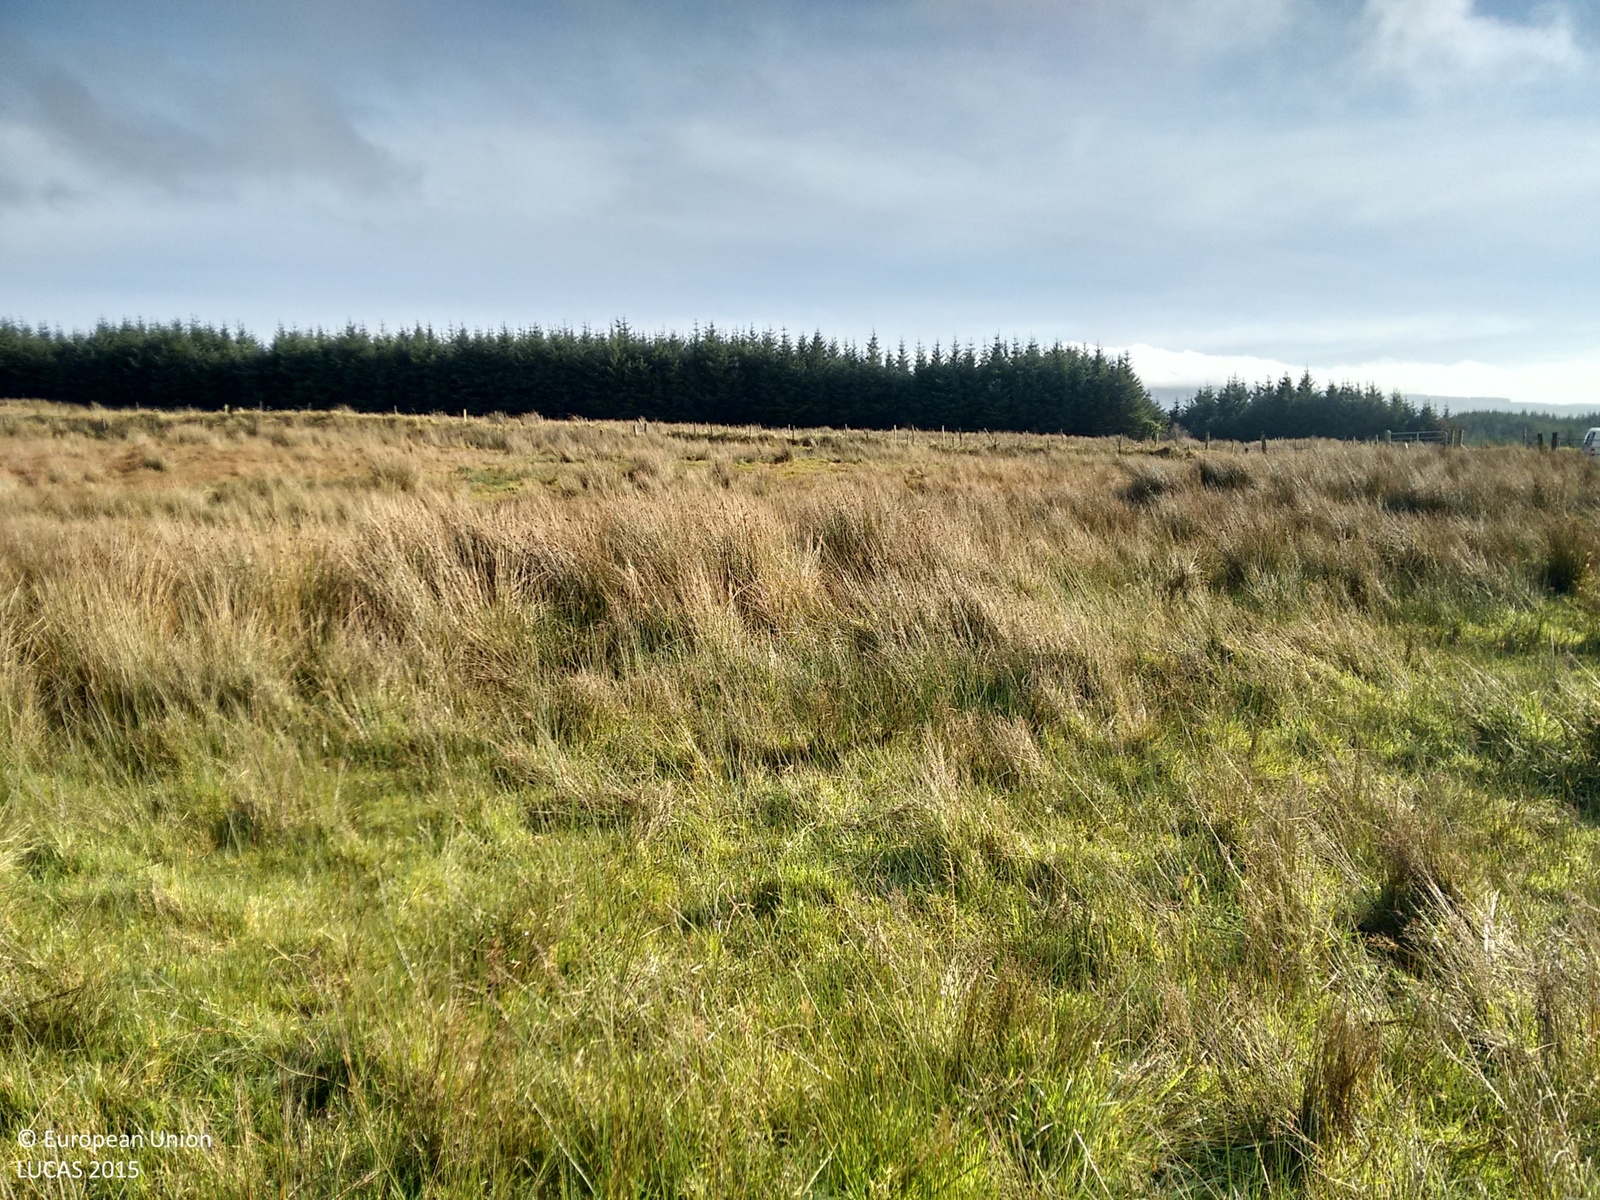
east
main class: Grassland
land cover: Grassland without tree/shrub cover
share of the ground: > 75 %
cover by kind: herbaceous plants 100 %
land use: Agriculture (excluding fallow land and kitchen gardens)
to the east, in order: Grassland without tree/shrub cover; Ponds and wetlands; Ditches and canals; Grassland without tree/shrub cover; Fences; Shruby margins; Ditches and canals; Paved roads, cycling and walking lanes; Ditches and canals; Fences; Grassland without tree/shrub cover; Ditches and canals; Grassland without tree/shrub cover; Ditches and canals; Fences; Spruce dominated coniferous woodland; Ditches and canals; Spruce dominated coniferous woodland
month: October
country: IE
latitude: 54.1045
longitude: -8.1180
